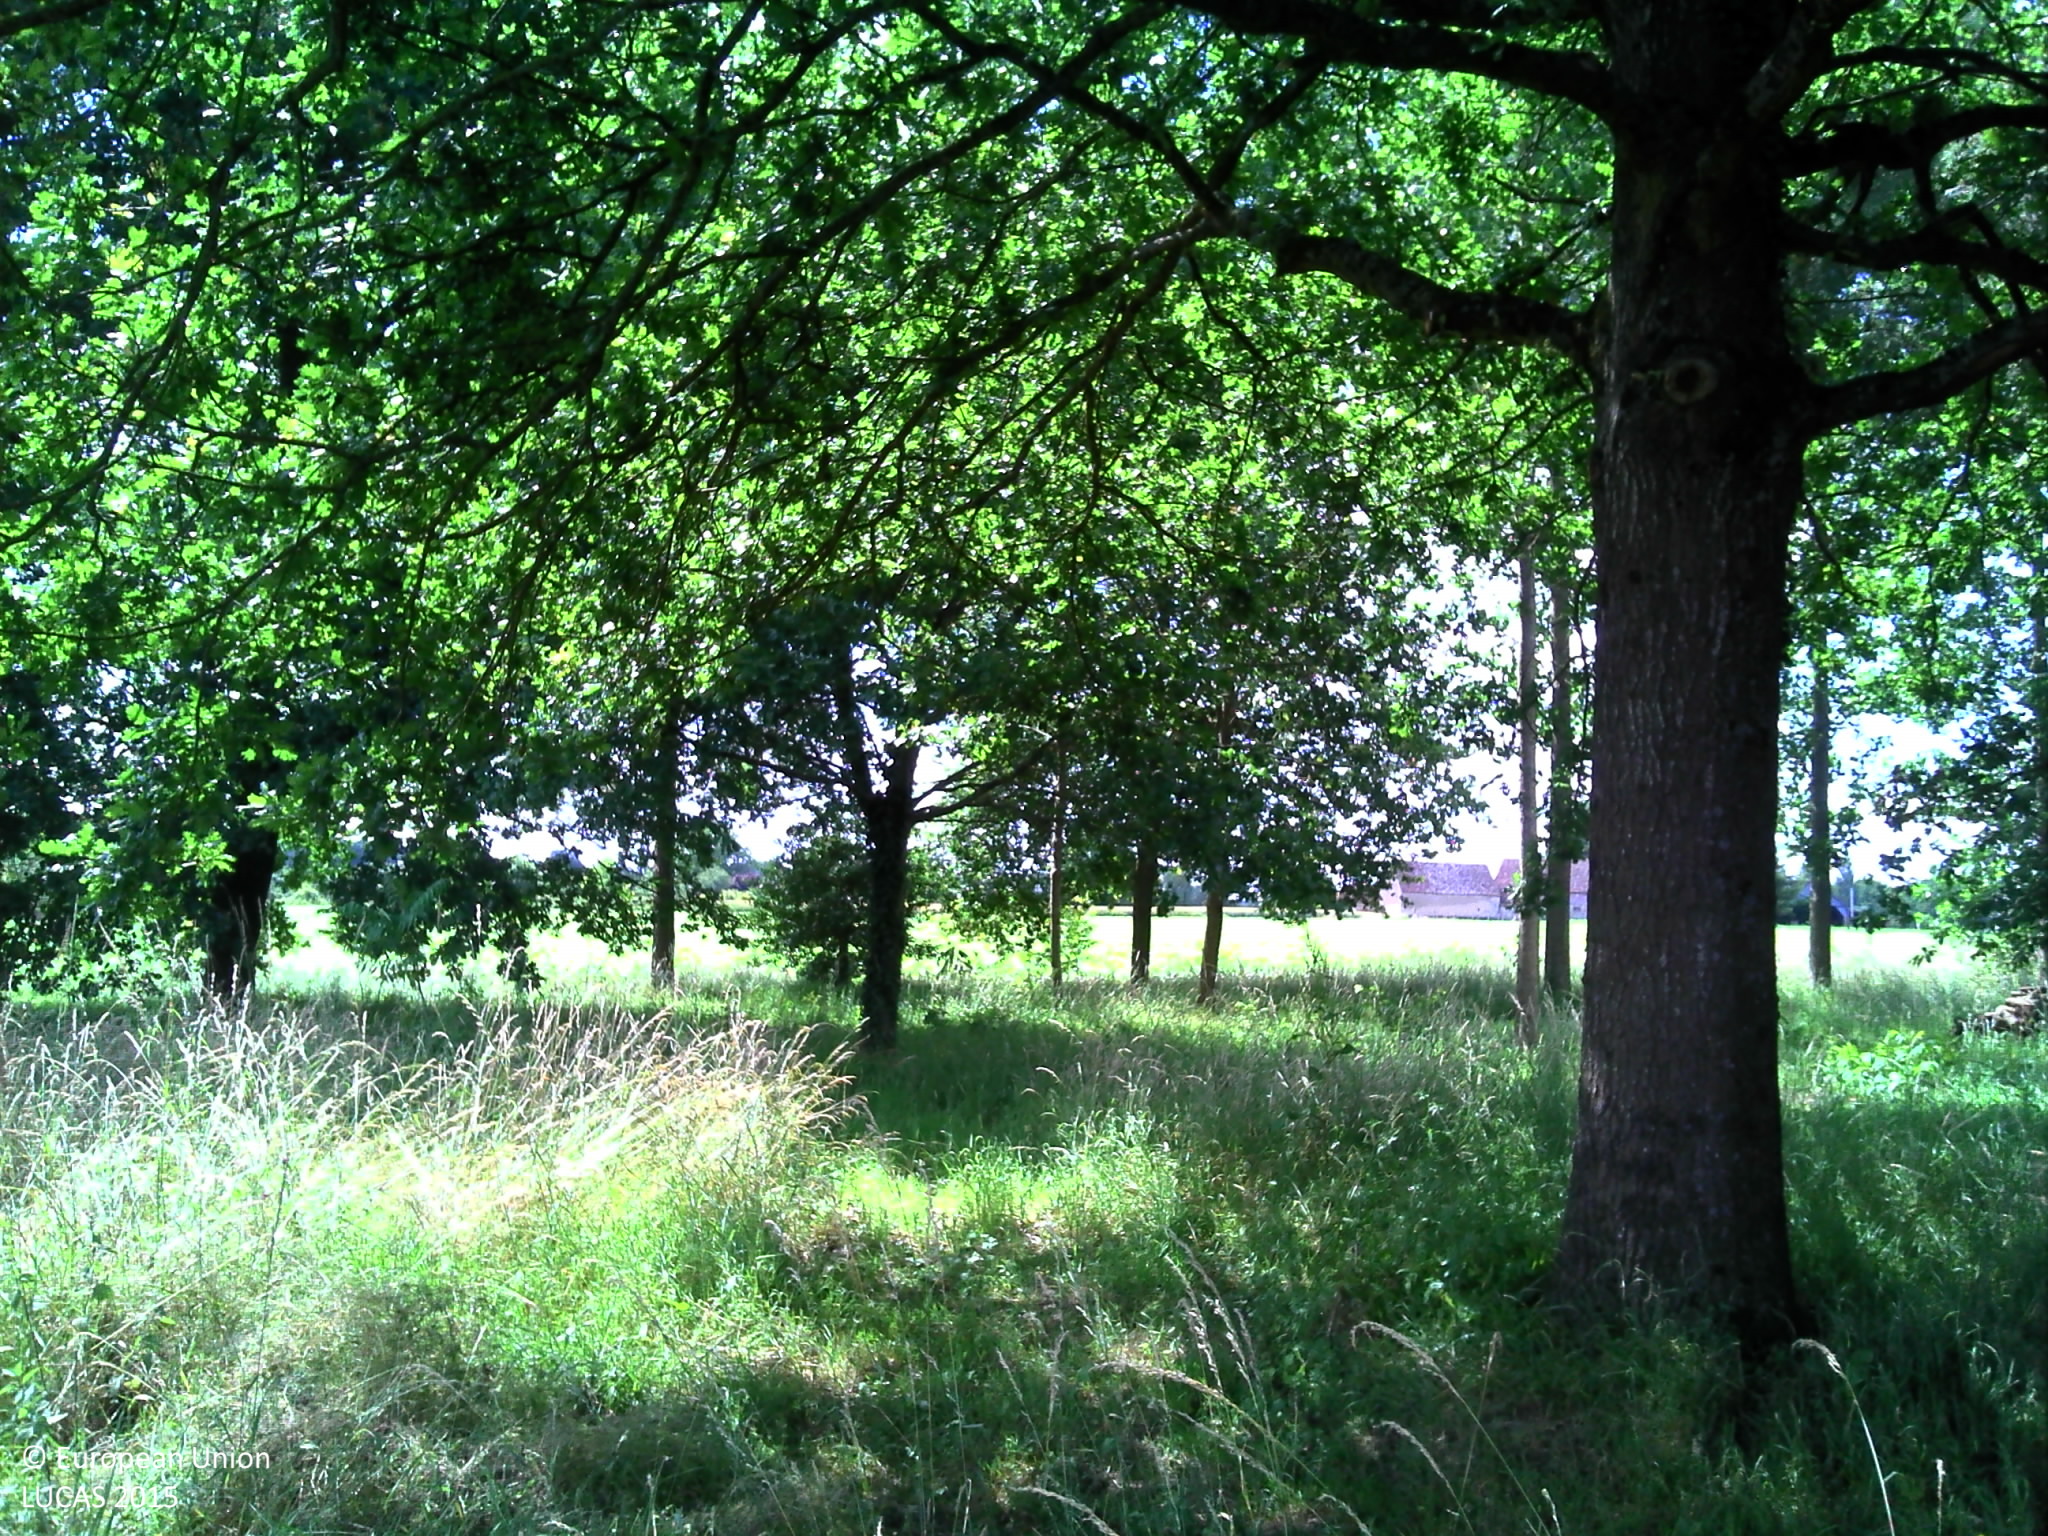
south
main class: Cropland
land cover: Rape and turnip rape
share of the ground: > 75 %
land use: Agriculture (excluding fallow land and kitchen gardens)
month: June
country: FR
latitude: 47.8813
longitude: 0.2534
